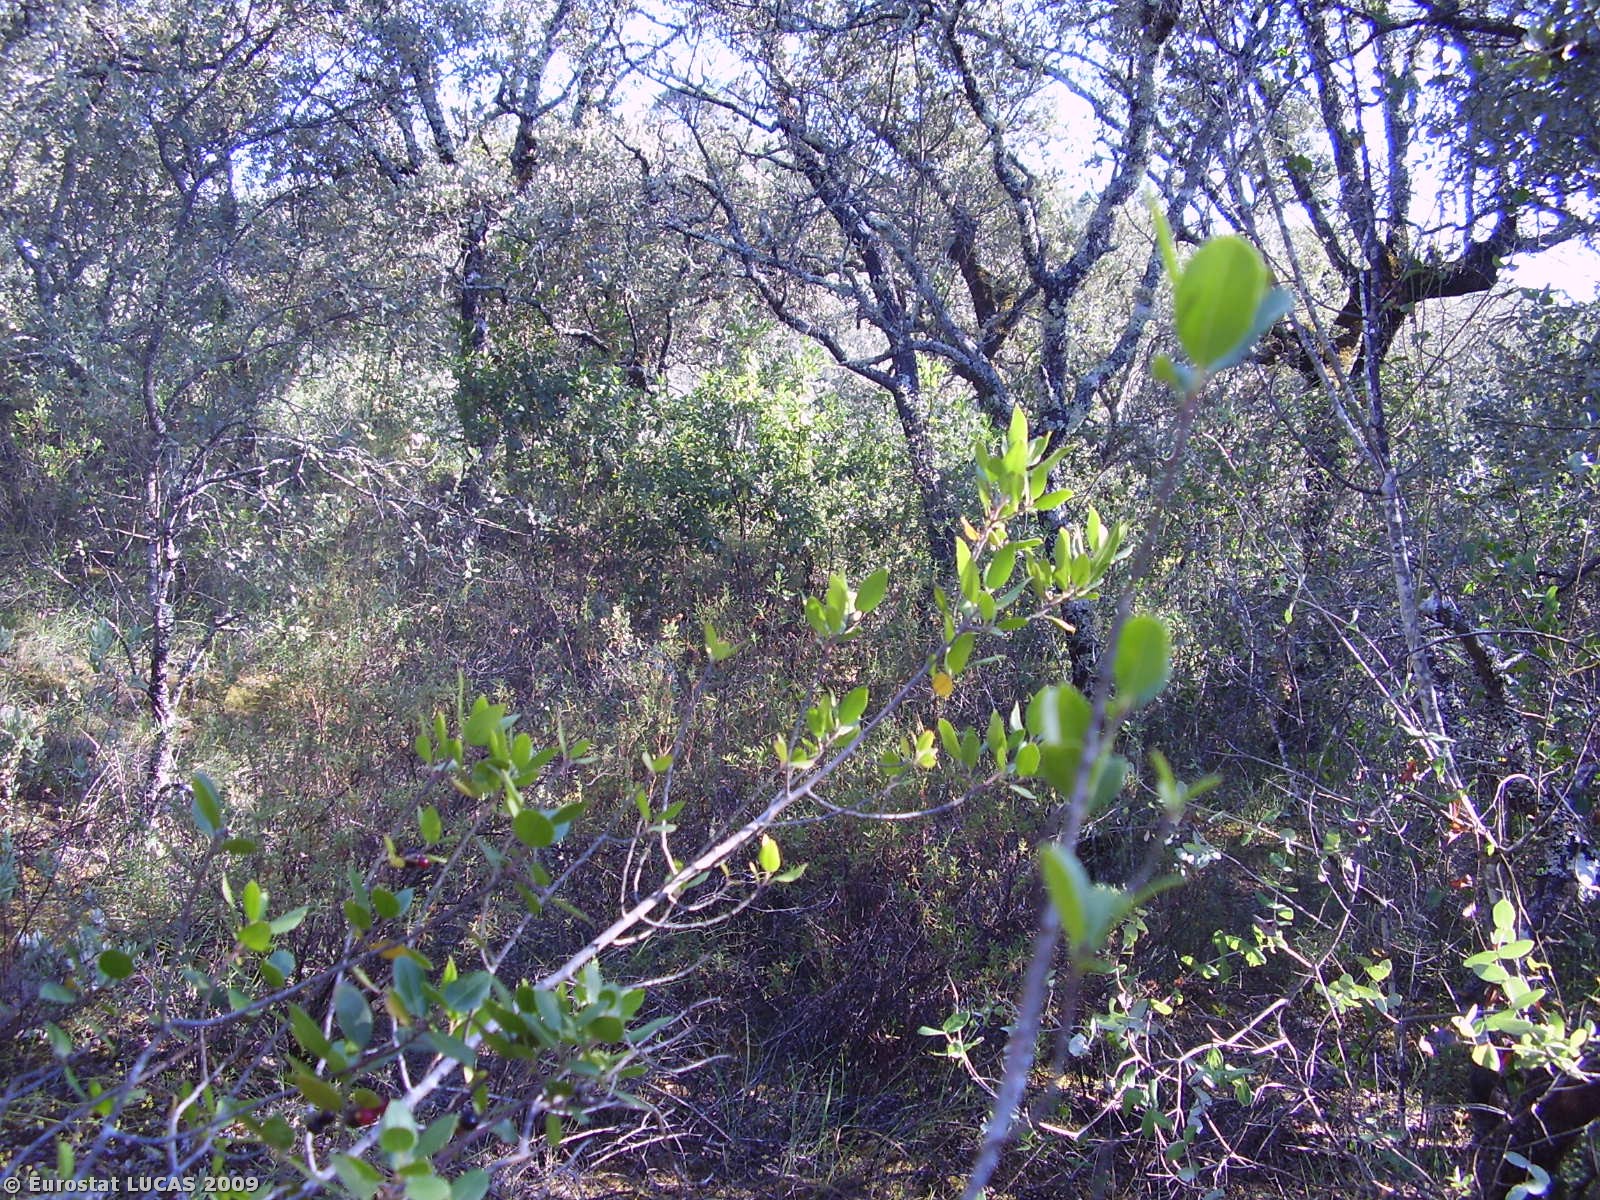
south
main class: Woodland
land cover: Broadleaved woodland
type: broadleaved evergreen forest
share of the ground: 50 - 75 %
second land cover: Shrubland with sparse tree cover
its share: 25 - 50 %
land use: Forestry
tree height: > 5 m
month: July
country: PT
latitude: 39.6558
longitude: -8.4062
